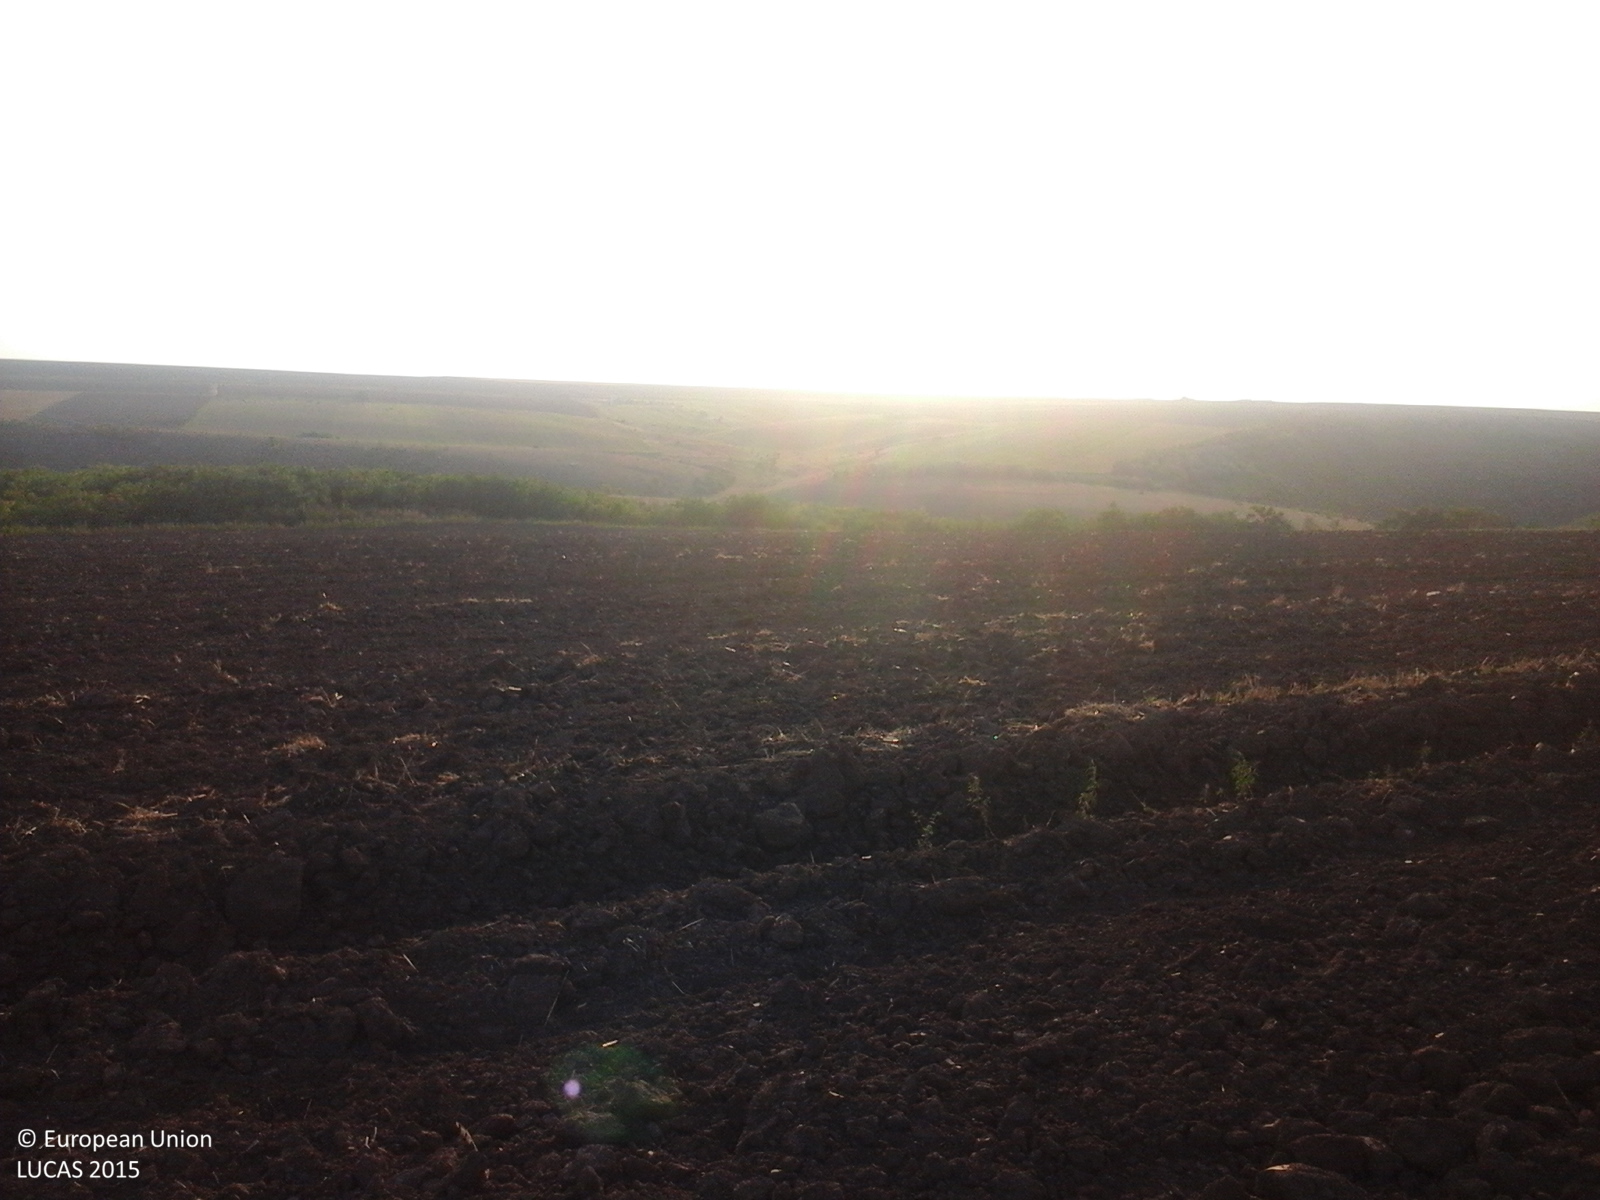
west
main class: Cropland
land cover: Common wheat
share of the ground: < 10 %
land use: Agriculture (excluding fallow land and kitchen gardens)
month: August
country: RO
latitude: 43.9665
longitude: 28.0640
